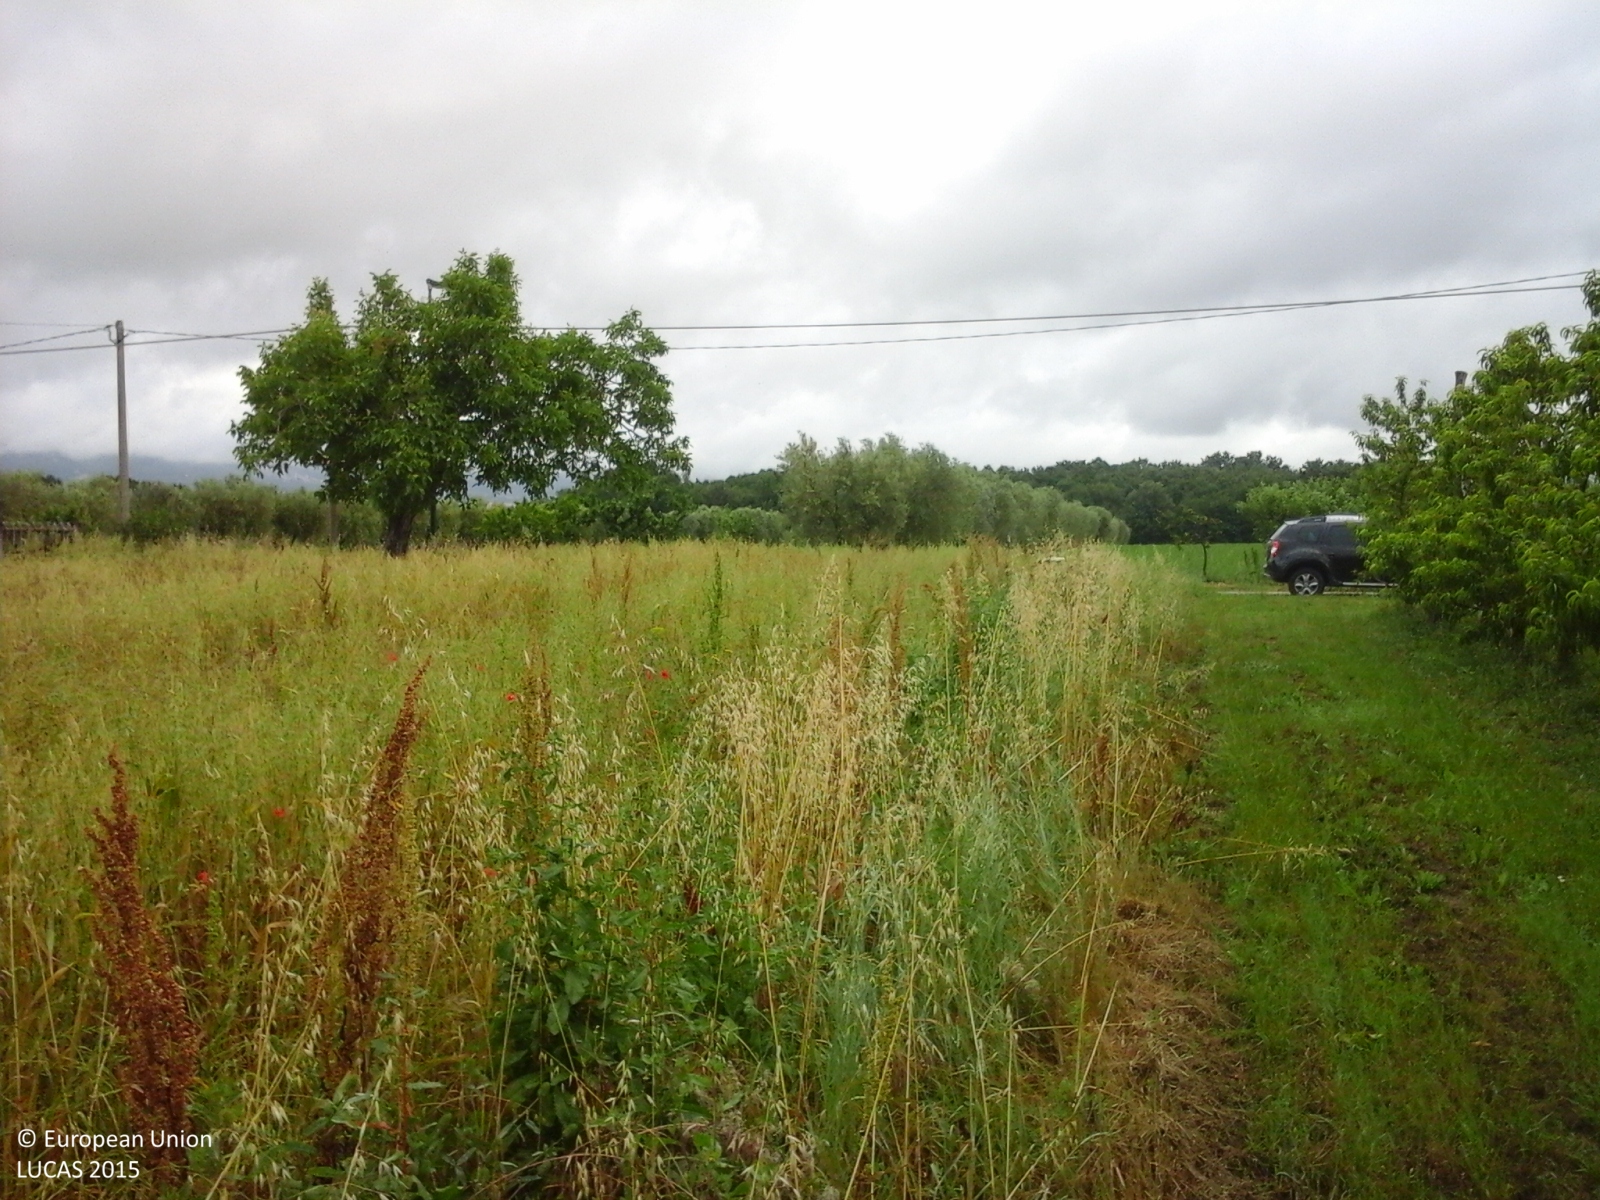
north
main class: Cropland
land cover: Mixed cereals for fodder
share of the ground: > 75 %
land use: Agriculture (excluding fallow land and kitchen gardens)
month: May
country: IT
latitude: 40.5869
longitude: 15.1183
